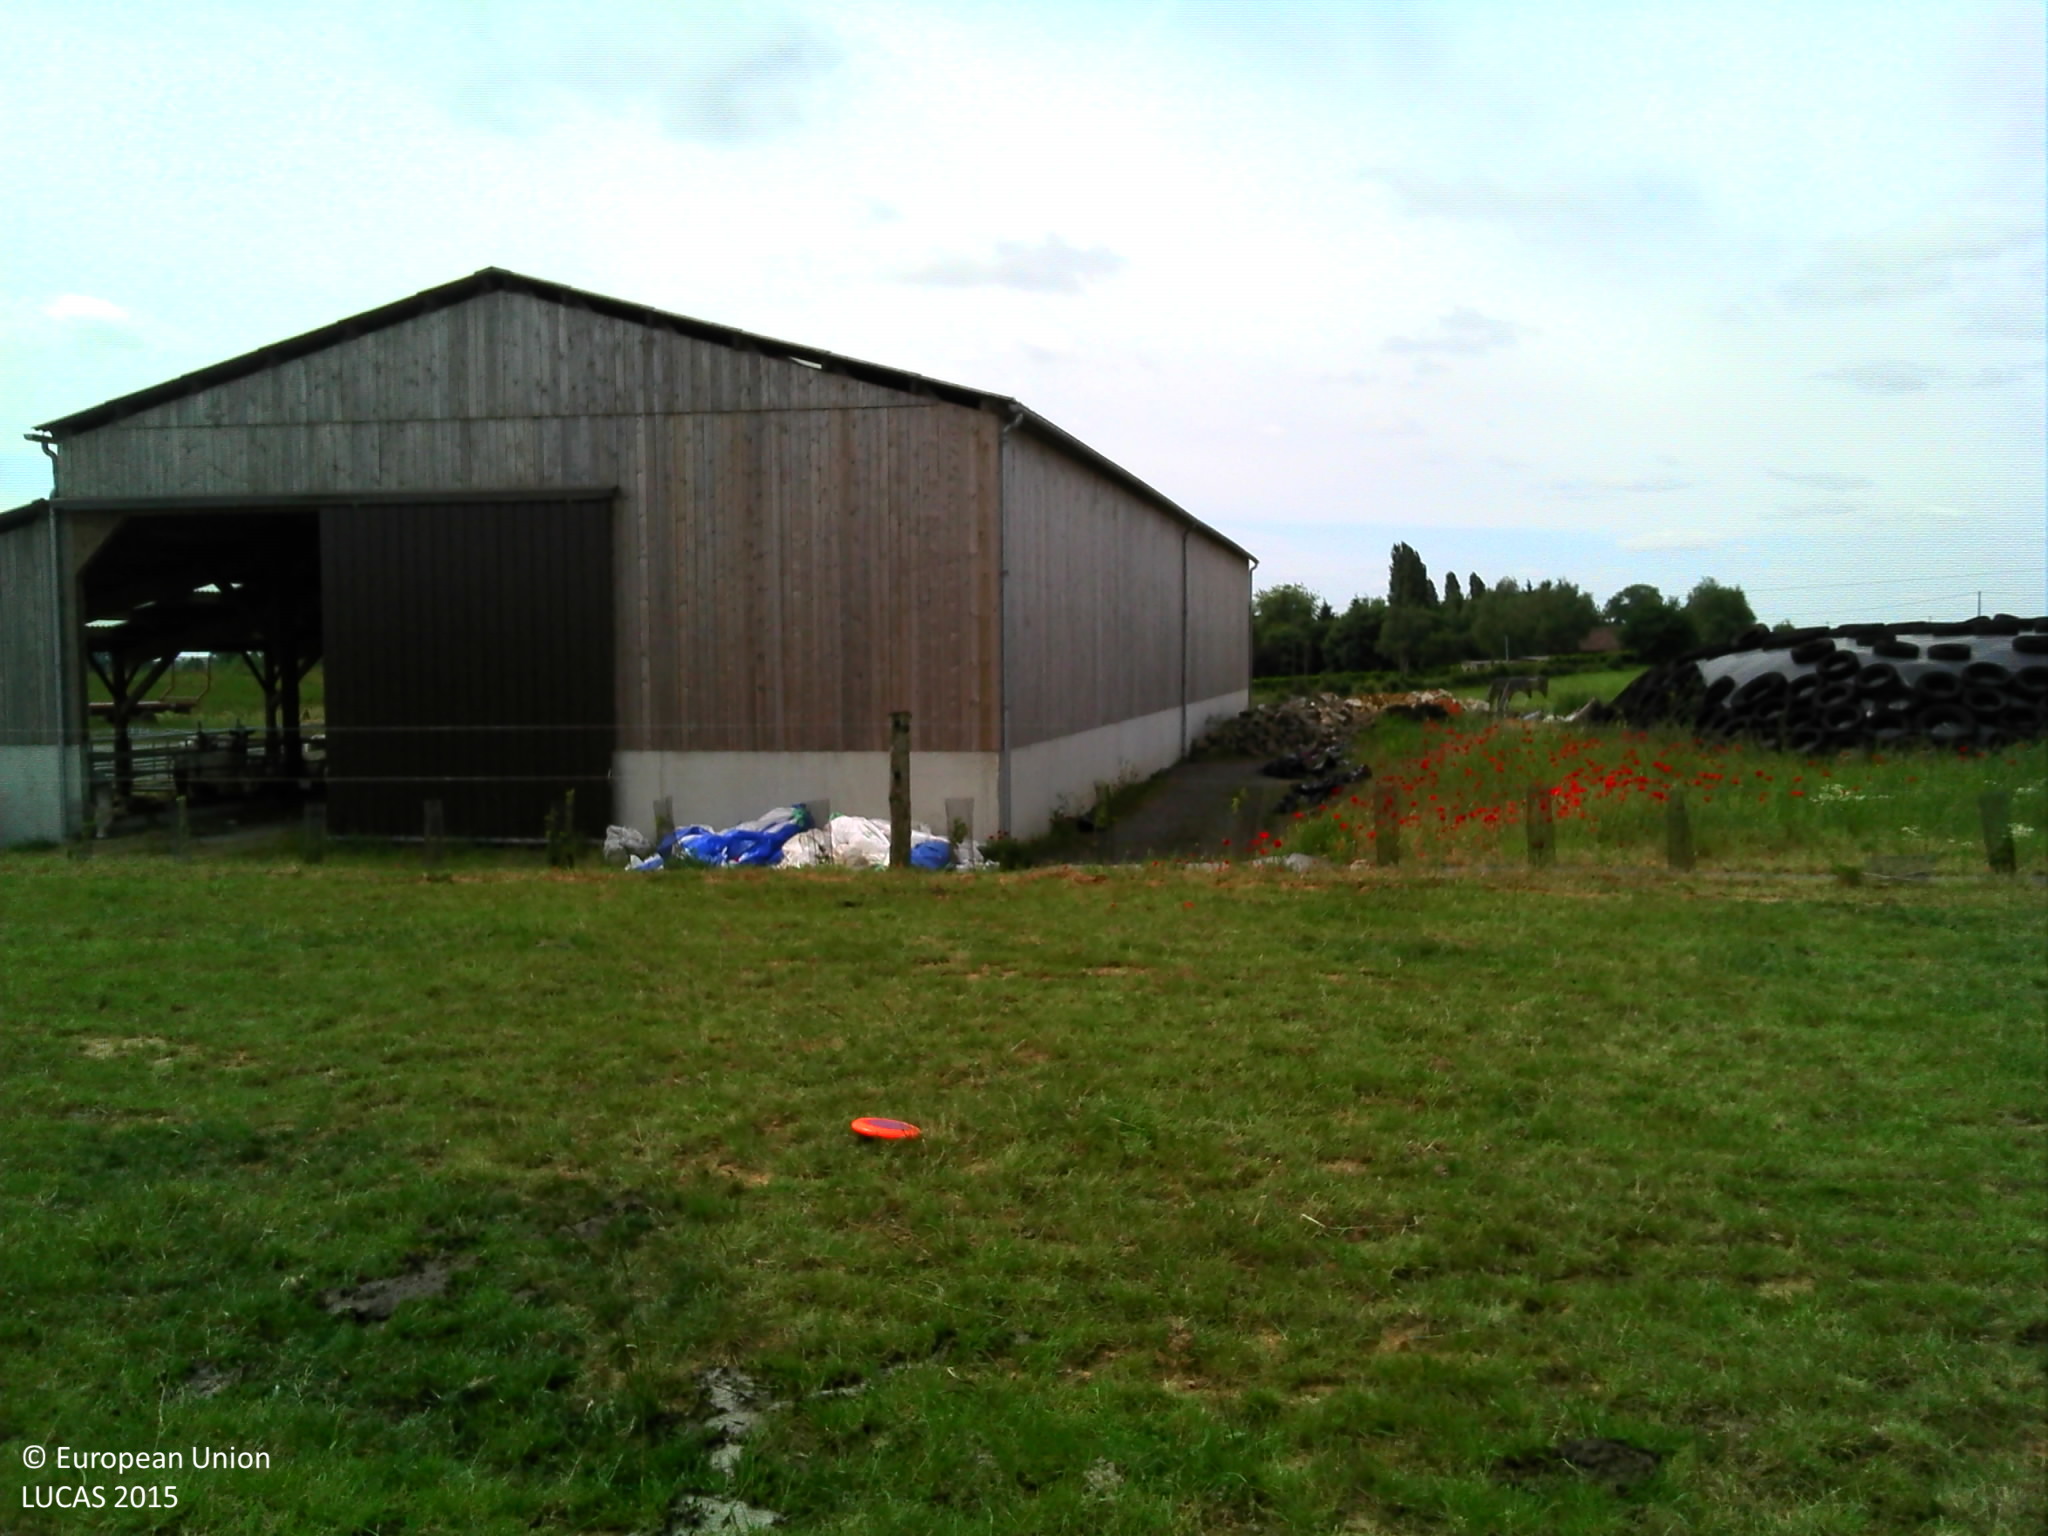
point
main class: Grassland
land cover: Grassland without tree/shrub cover
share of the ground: > 75 %
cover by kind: herbaceous plants 100 %
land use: Agriculture (excluding fallow land and kitchen gardens)
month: May
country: FR
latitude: 47.9868
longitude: 0.0167
